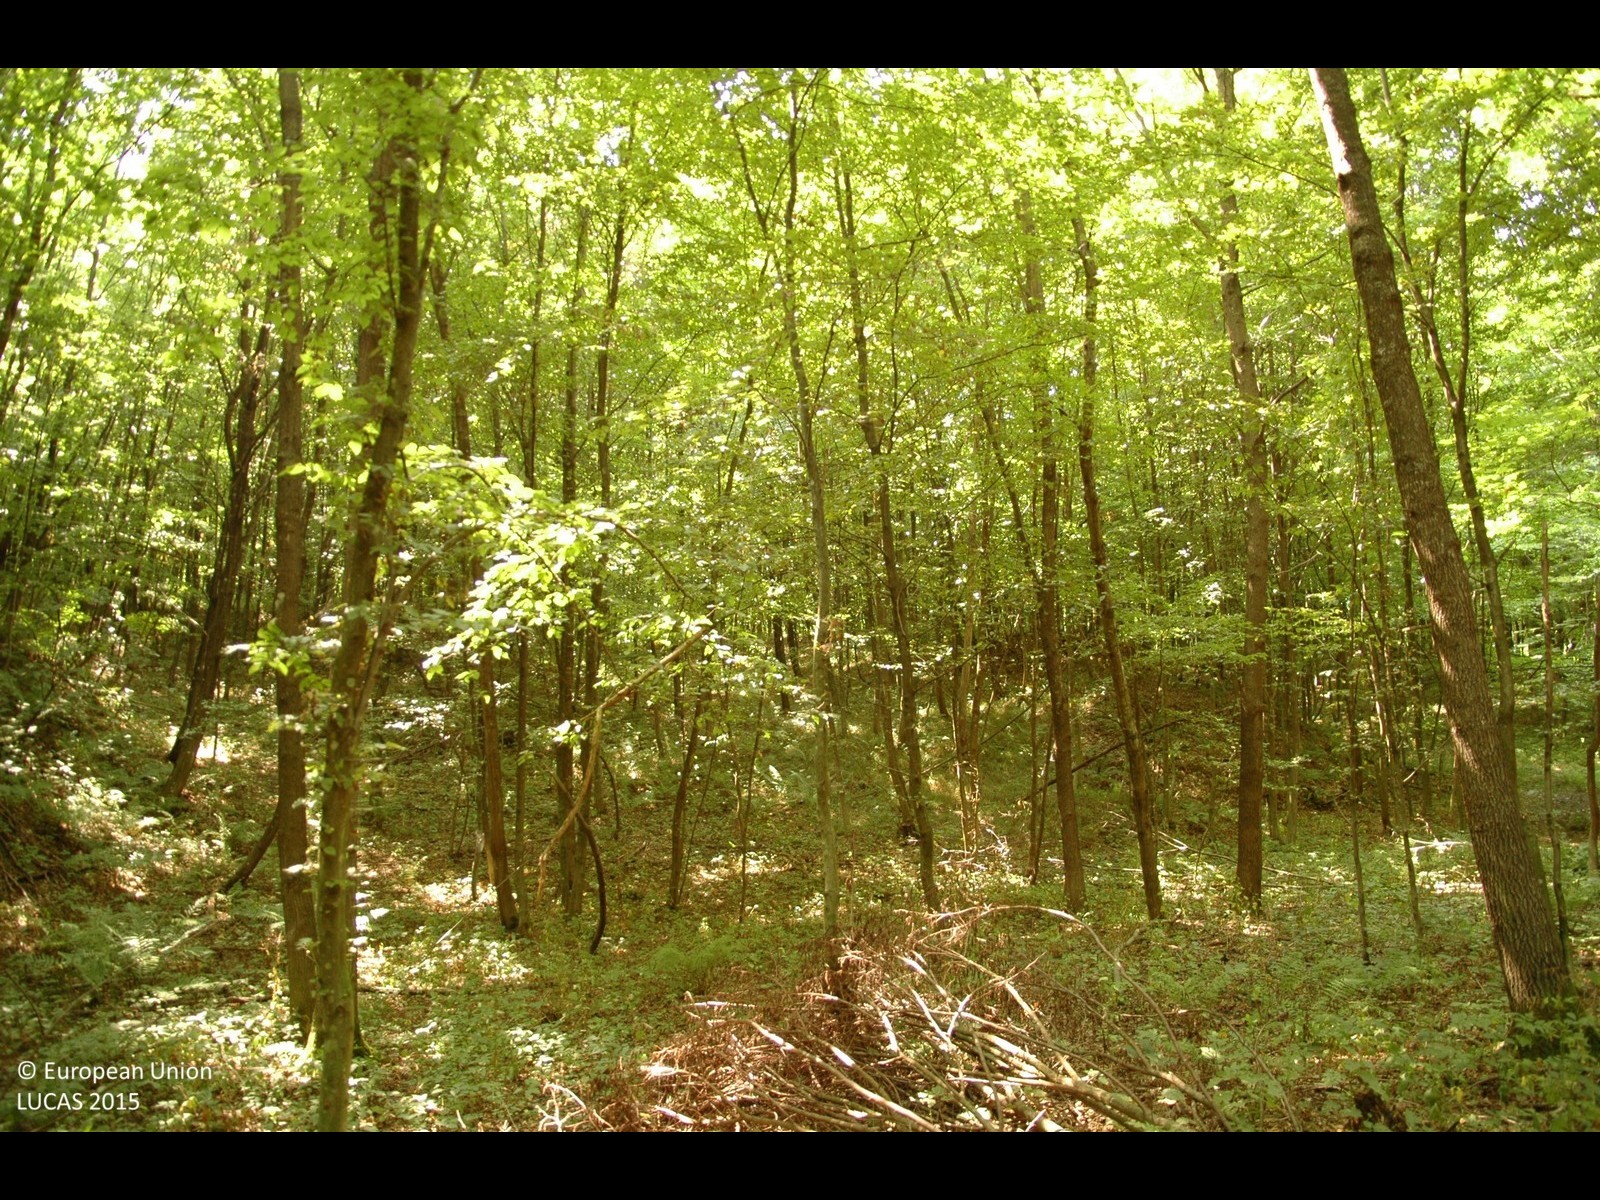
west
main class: Woodland
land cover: Broadleaved woodland
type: mesophytic deciduous forest
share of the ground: > 75 %
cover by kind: broadleaved forest trees 100 %
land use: Forestry
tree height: > 5 m
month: July
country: HR
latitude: 46.1594
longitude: 16.6958
